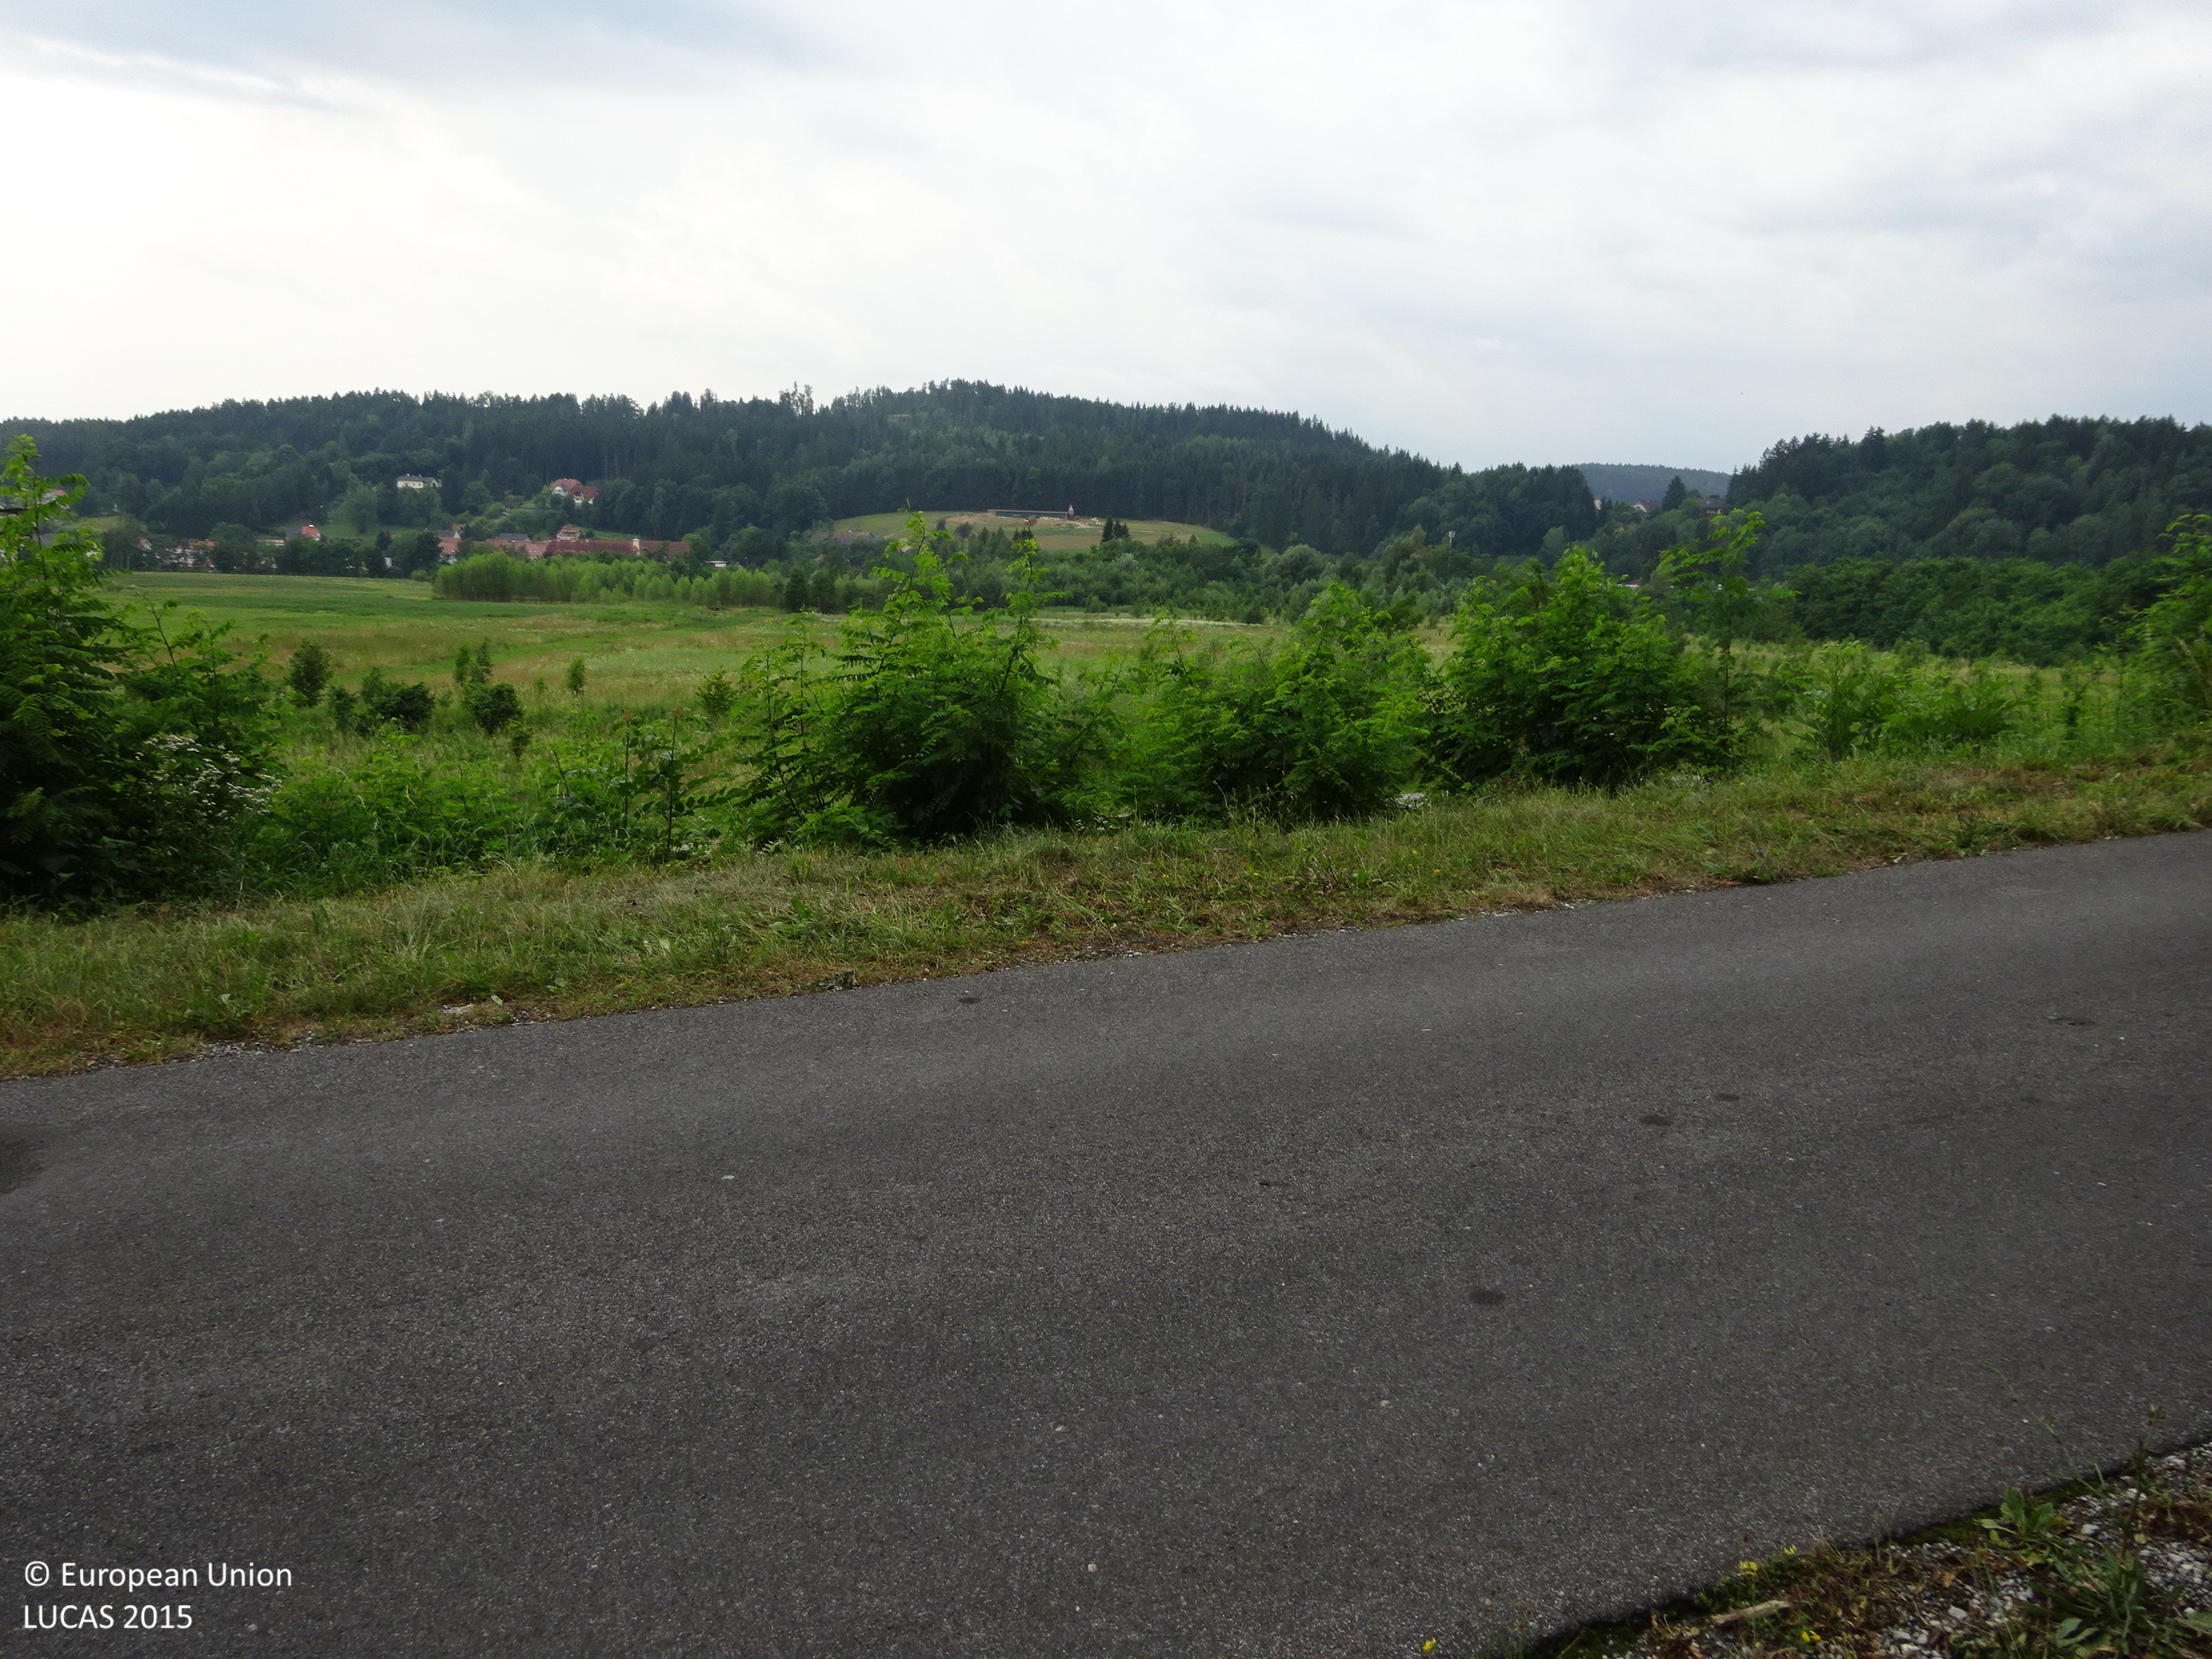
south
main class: Woodland
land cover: Spruce dominated mixed woodland
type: mountainous beech forest
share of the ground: > 75 %
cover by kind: coniferous forest trees 60 %, broadleaved forest trees 40 %
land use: Forestry
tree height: > 5 m
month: July
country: AT
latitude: 47.0586
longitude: 15.1206
